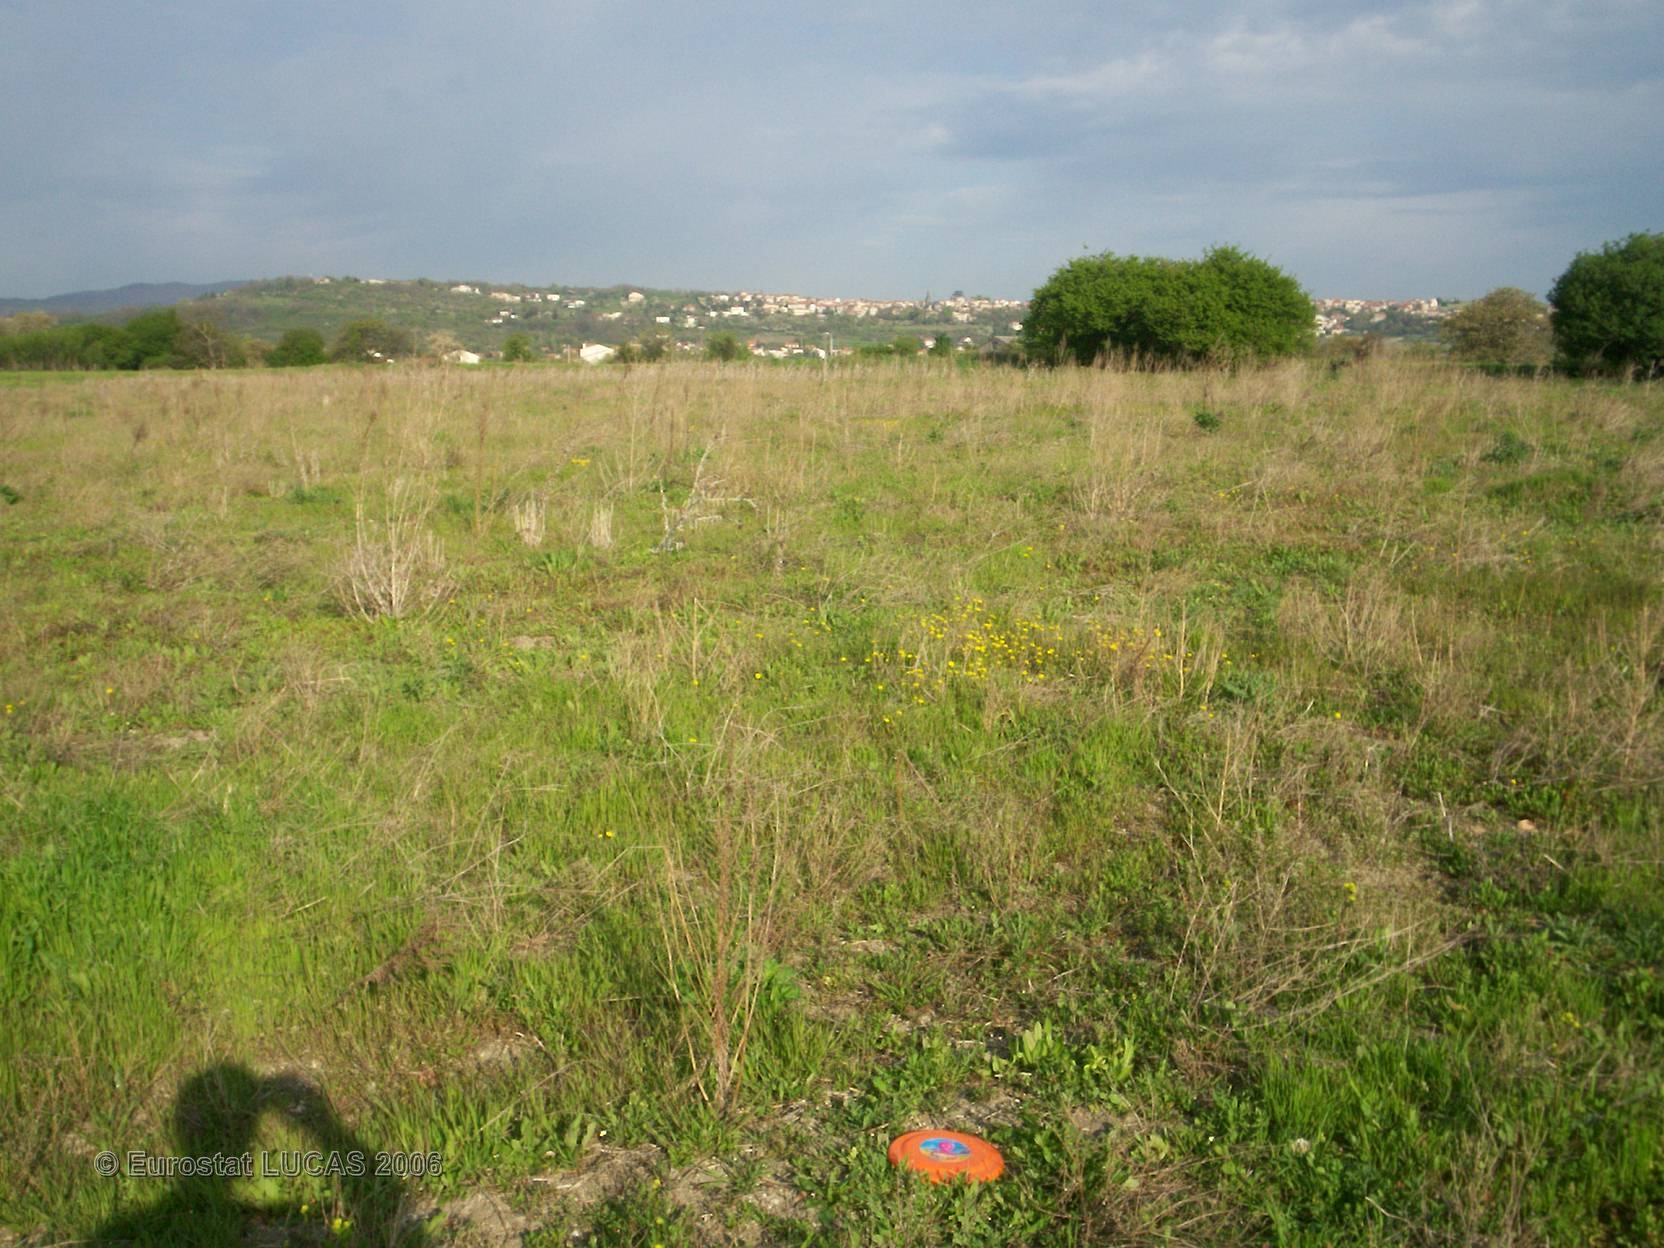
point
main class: Grassland
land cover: Grassland without tree/shrub cover
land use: Fallow land
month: April
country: FR
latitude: 45.8398
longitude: 3.1113
